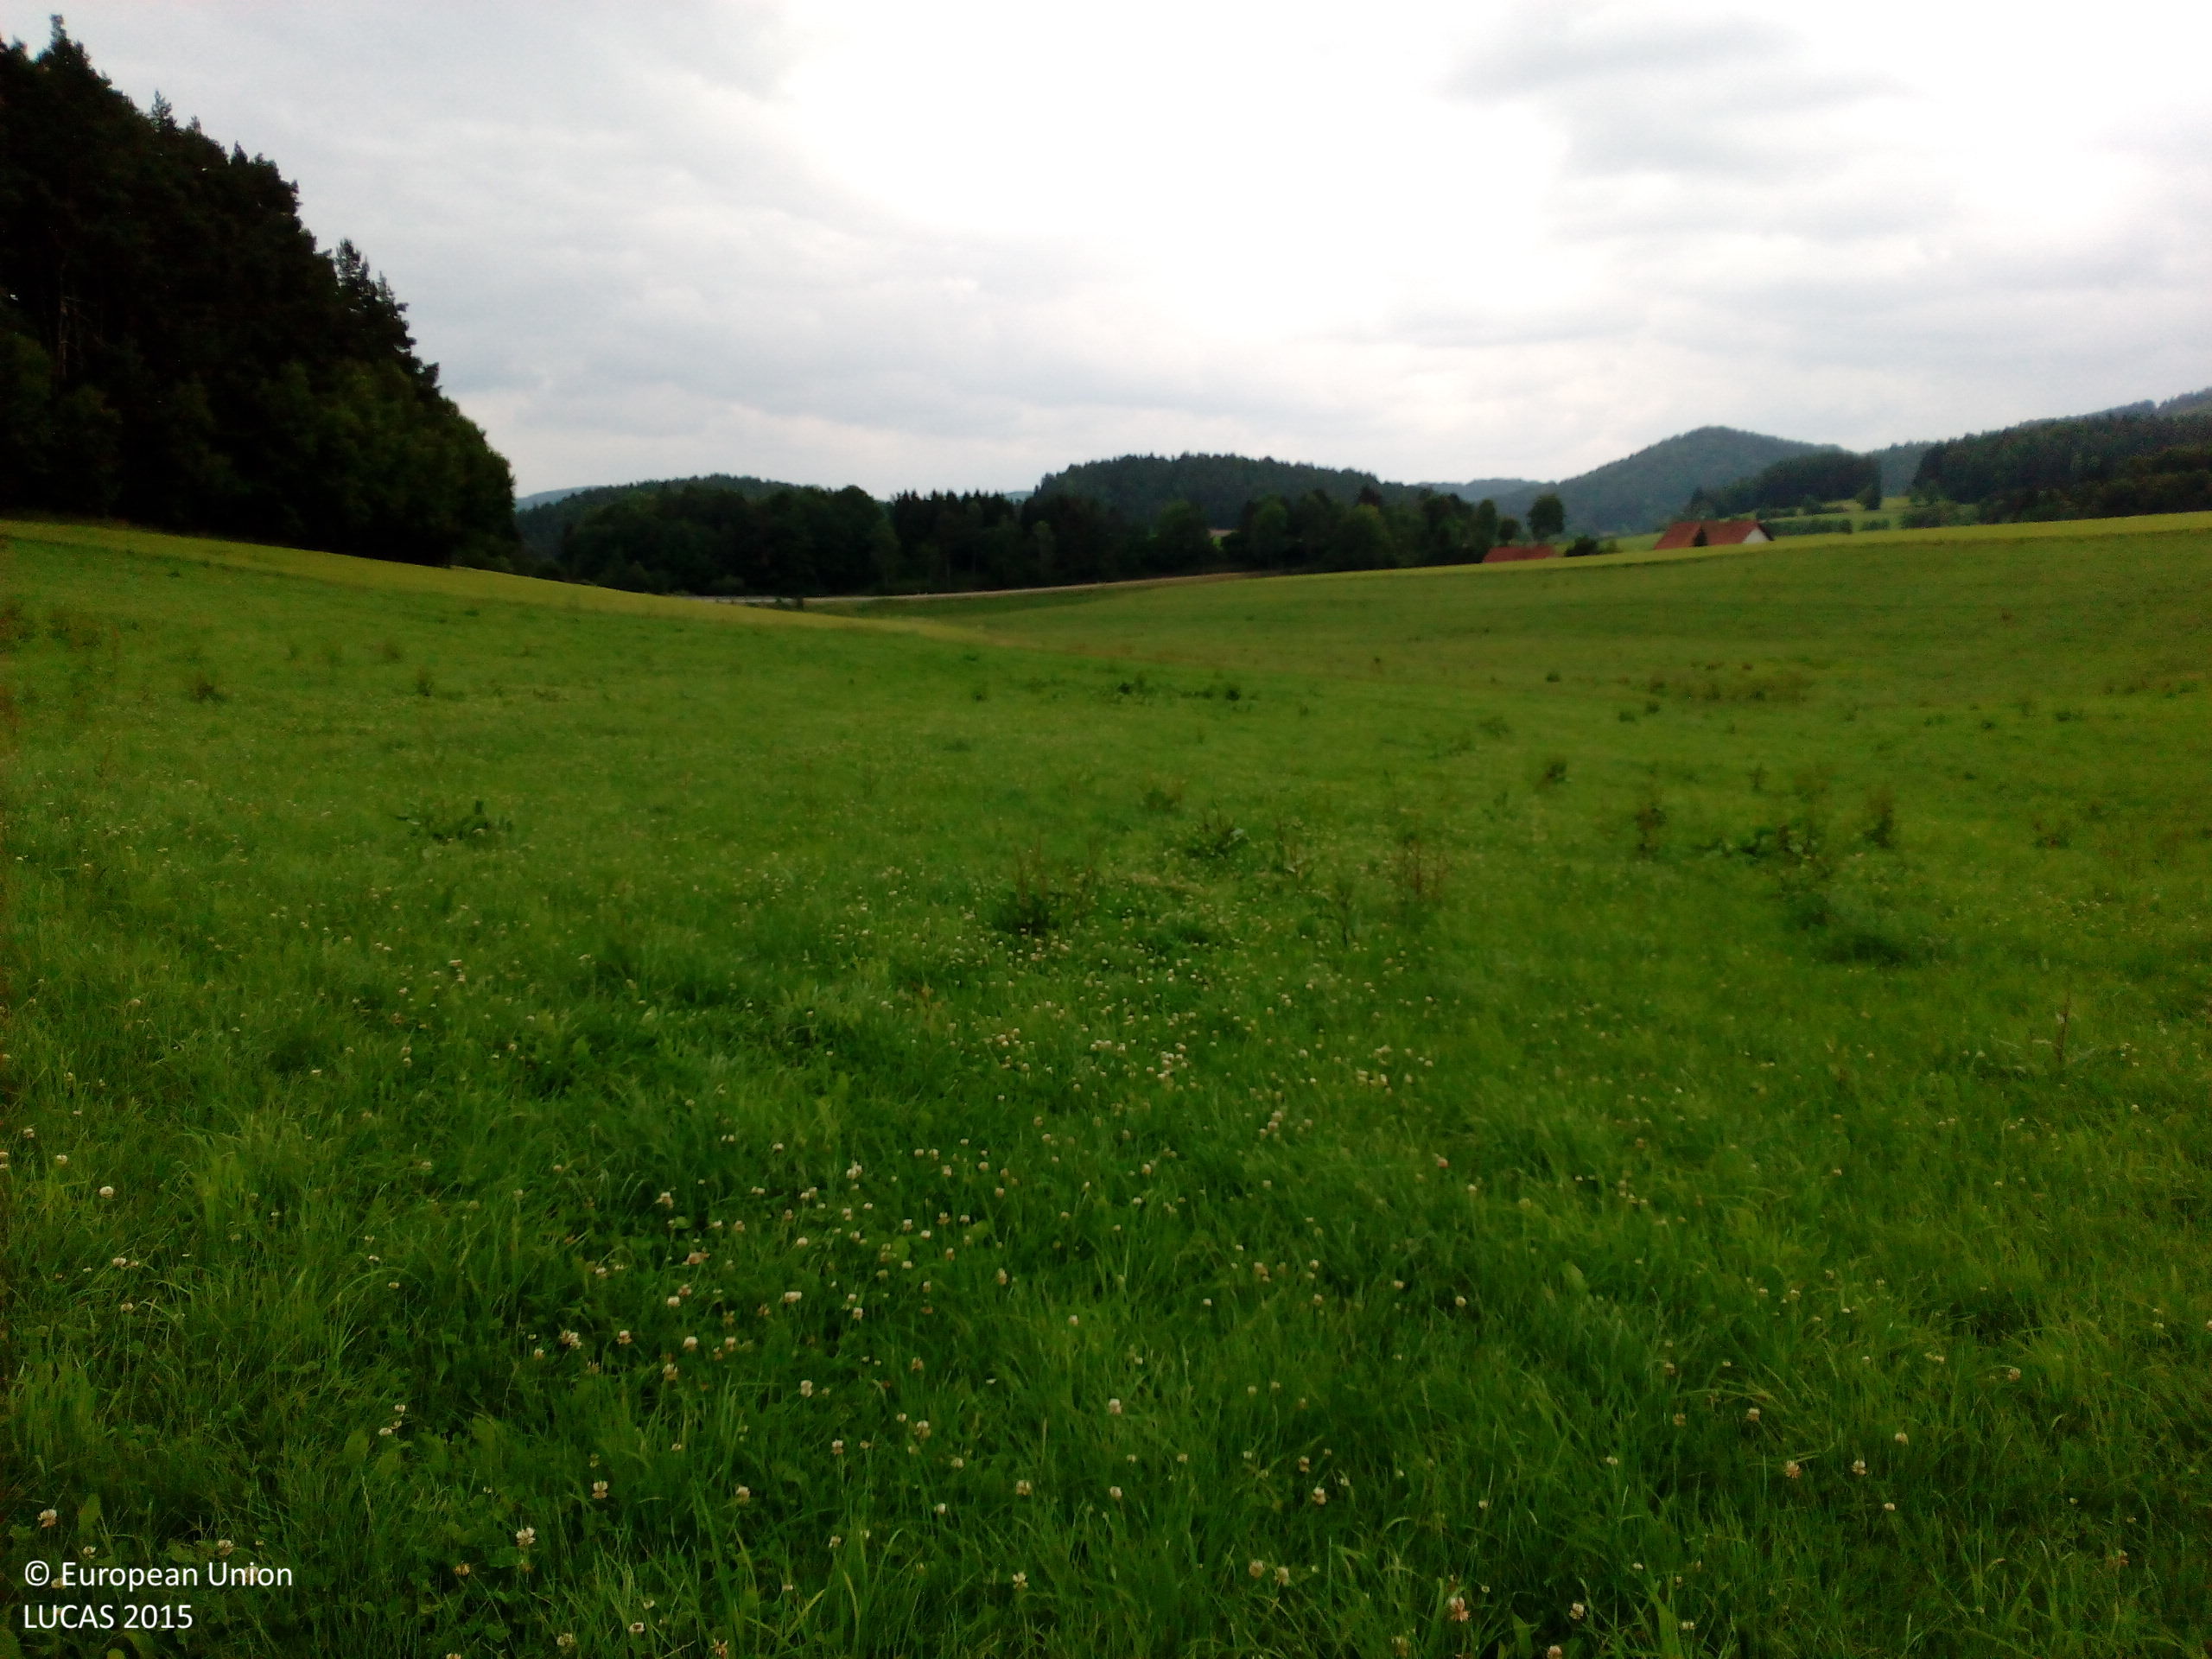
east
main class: Grassland
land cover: Grassland without tree/shrub cover
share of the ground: > 75 %
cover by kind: herbaceous plants 100 %
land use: Agriculture (excluding fallow land and kitchen gardens)
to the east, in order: Grassland without tree/shrub cover; Barley; Grassland without tree/shrub cover
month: June
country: DE
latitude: 49.1149
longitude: 12.4244
